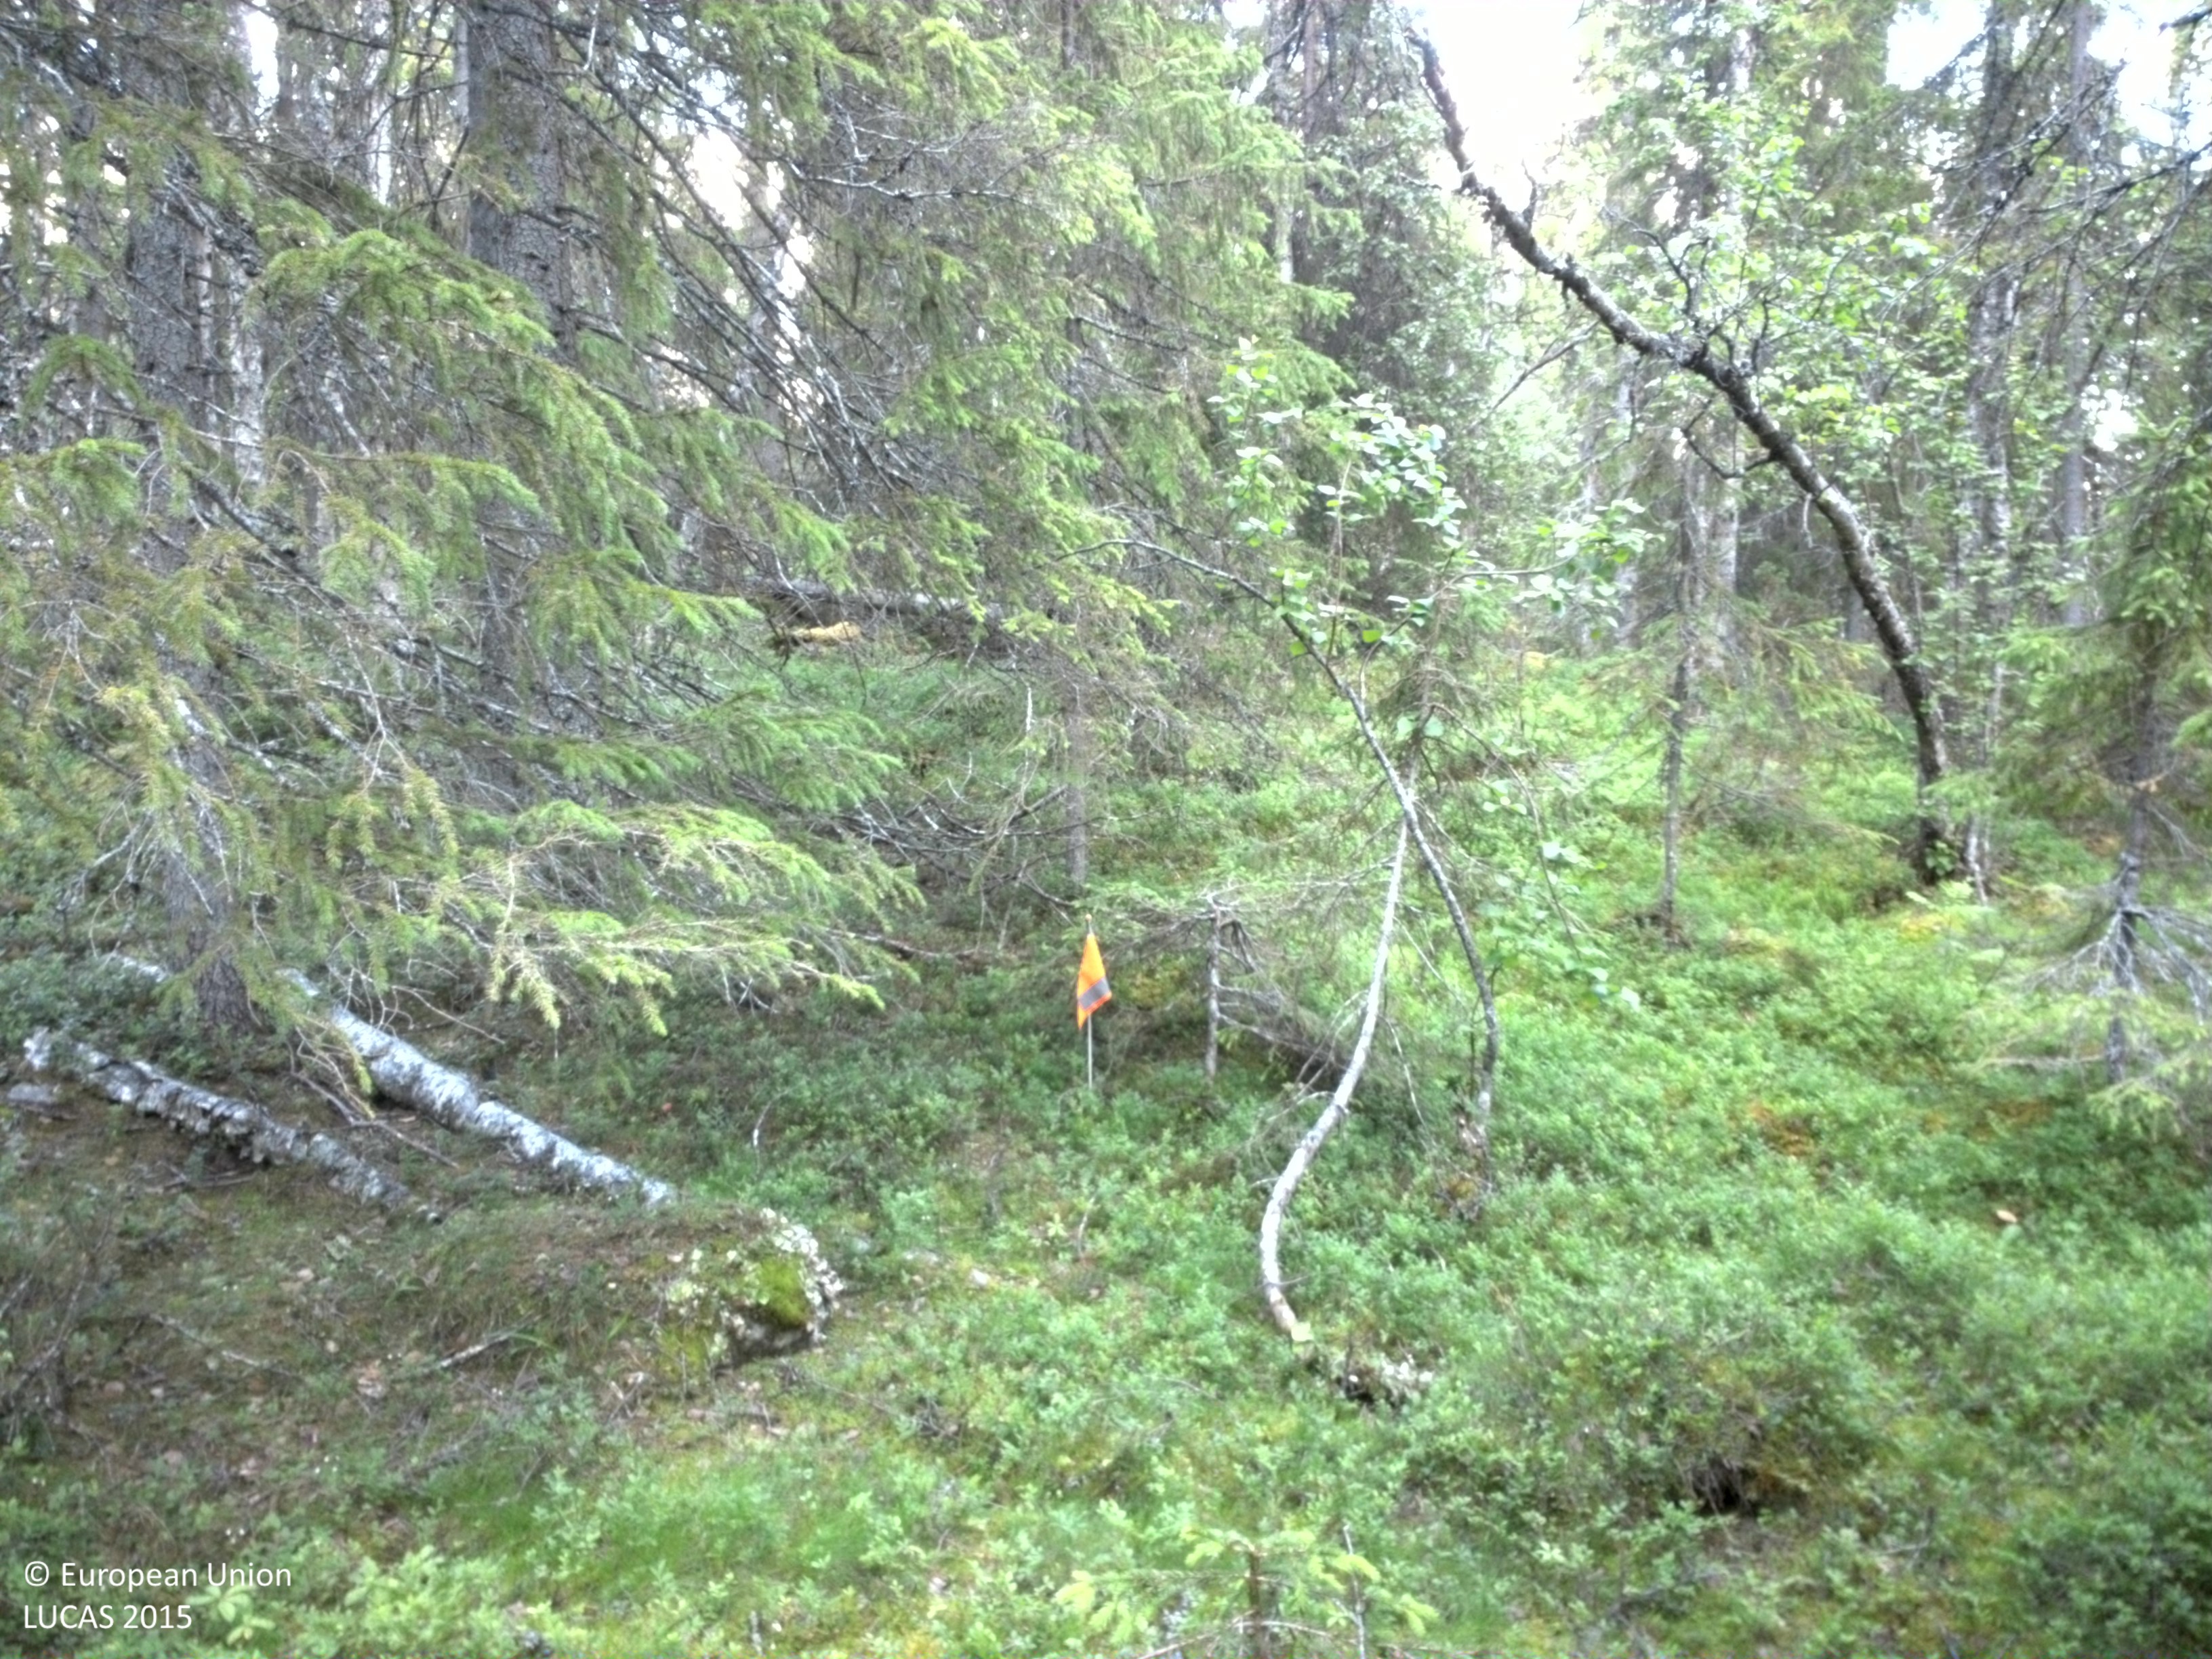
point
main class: Woodland
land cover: Spruce dominated coniferous woodland
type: boreal forest
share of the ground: 50 - 75 %
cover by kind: coniferous forest trees 40 %, shrubs 35 %, broadleaved forest trees 10 %, lichens and mosses 10 %, herbaceous plants 5 %
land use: Forestry
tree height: > 5 m
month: August
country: SE
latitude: 65.0481
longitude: 15.9356
